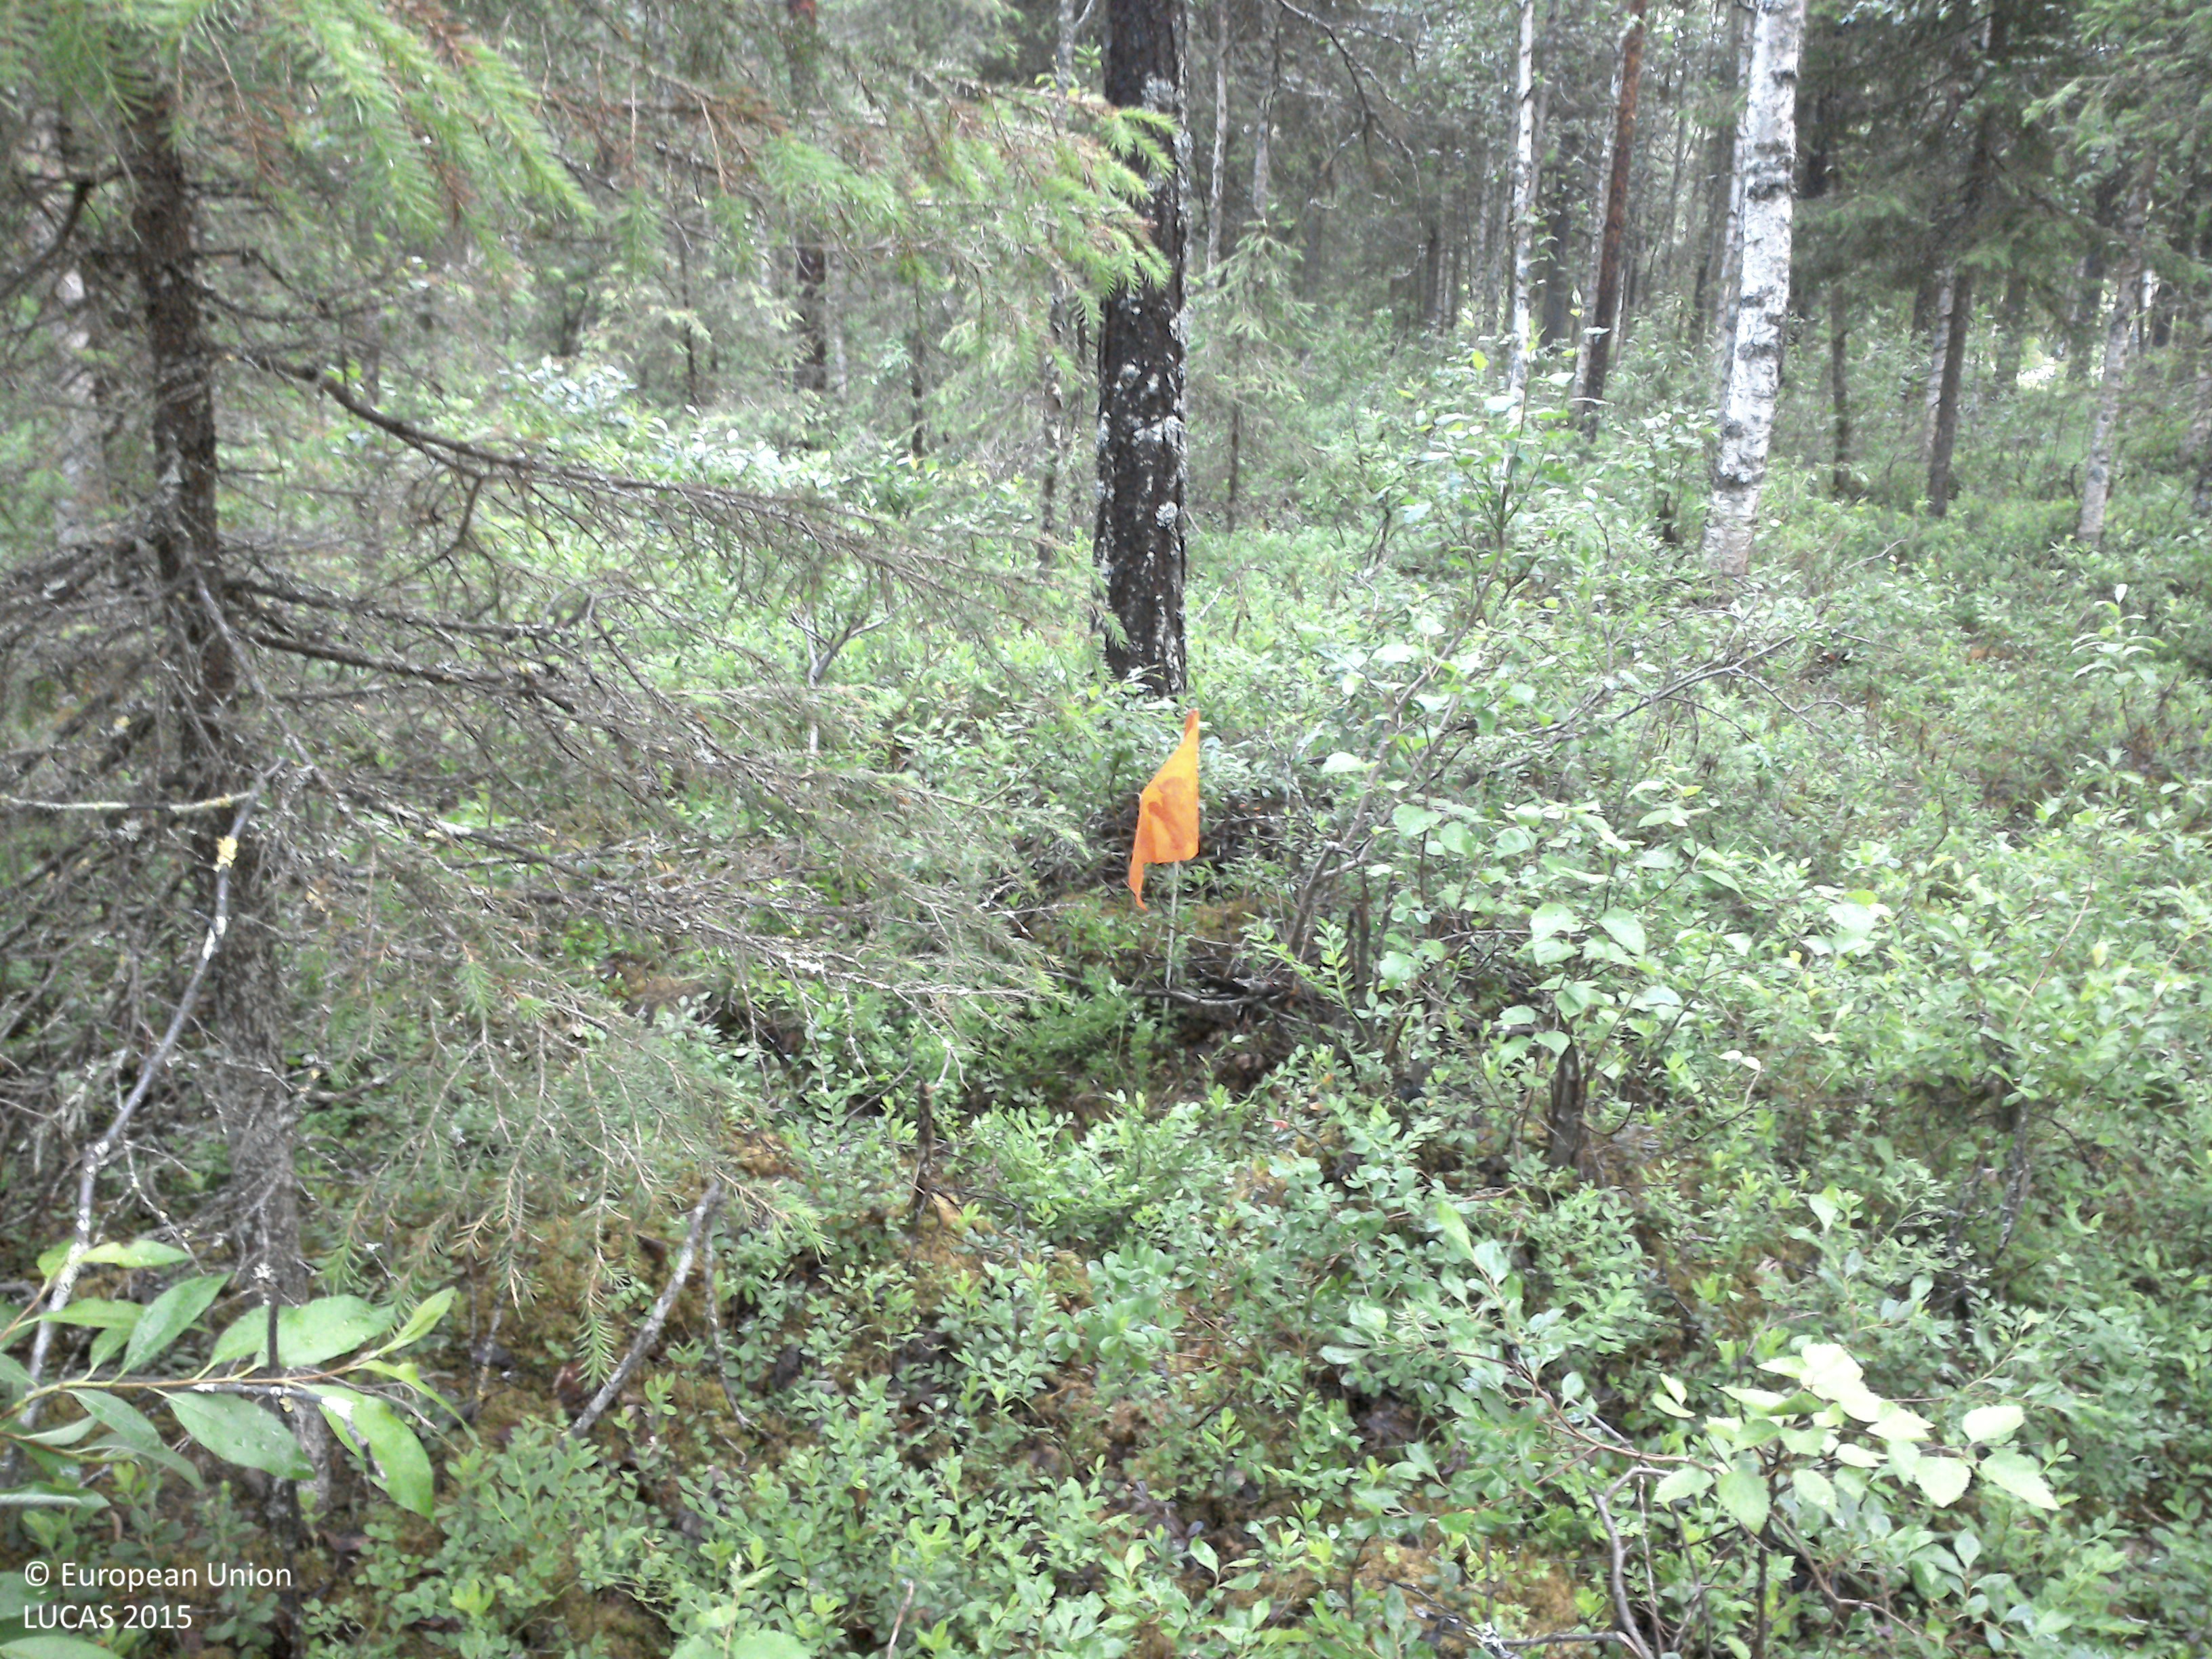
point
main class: Woodland
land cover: Pine dominated mixed woodland
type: boreal forest
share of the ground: 25 - 50 %
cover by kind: shrubs 65 %, coniferous forest trees 20 %, broadleaved forest trees 15 %
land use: Forestry
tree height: > 5 m
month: July
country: SE
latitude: 66.9578
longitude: 23.8335
